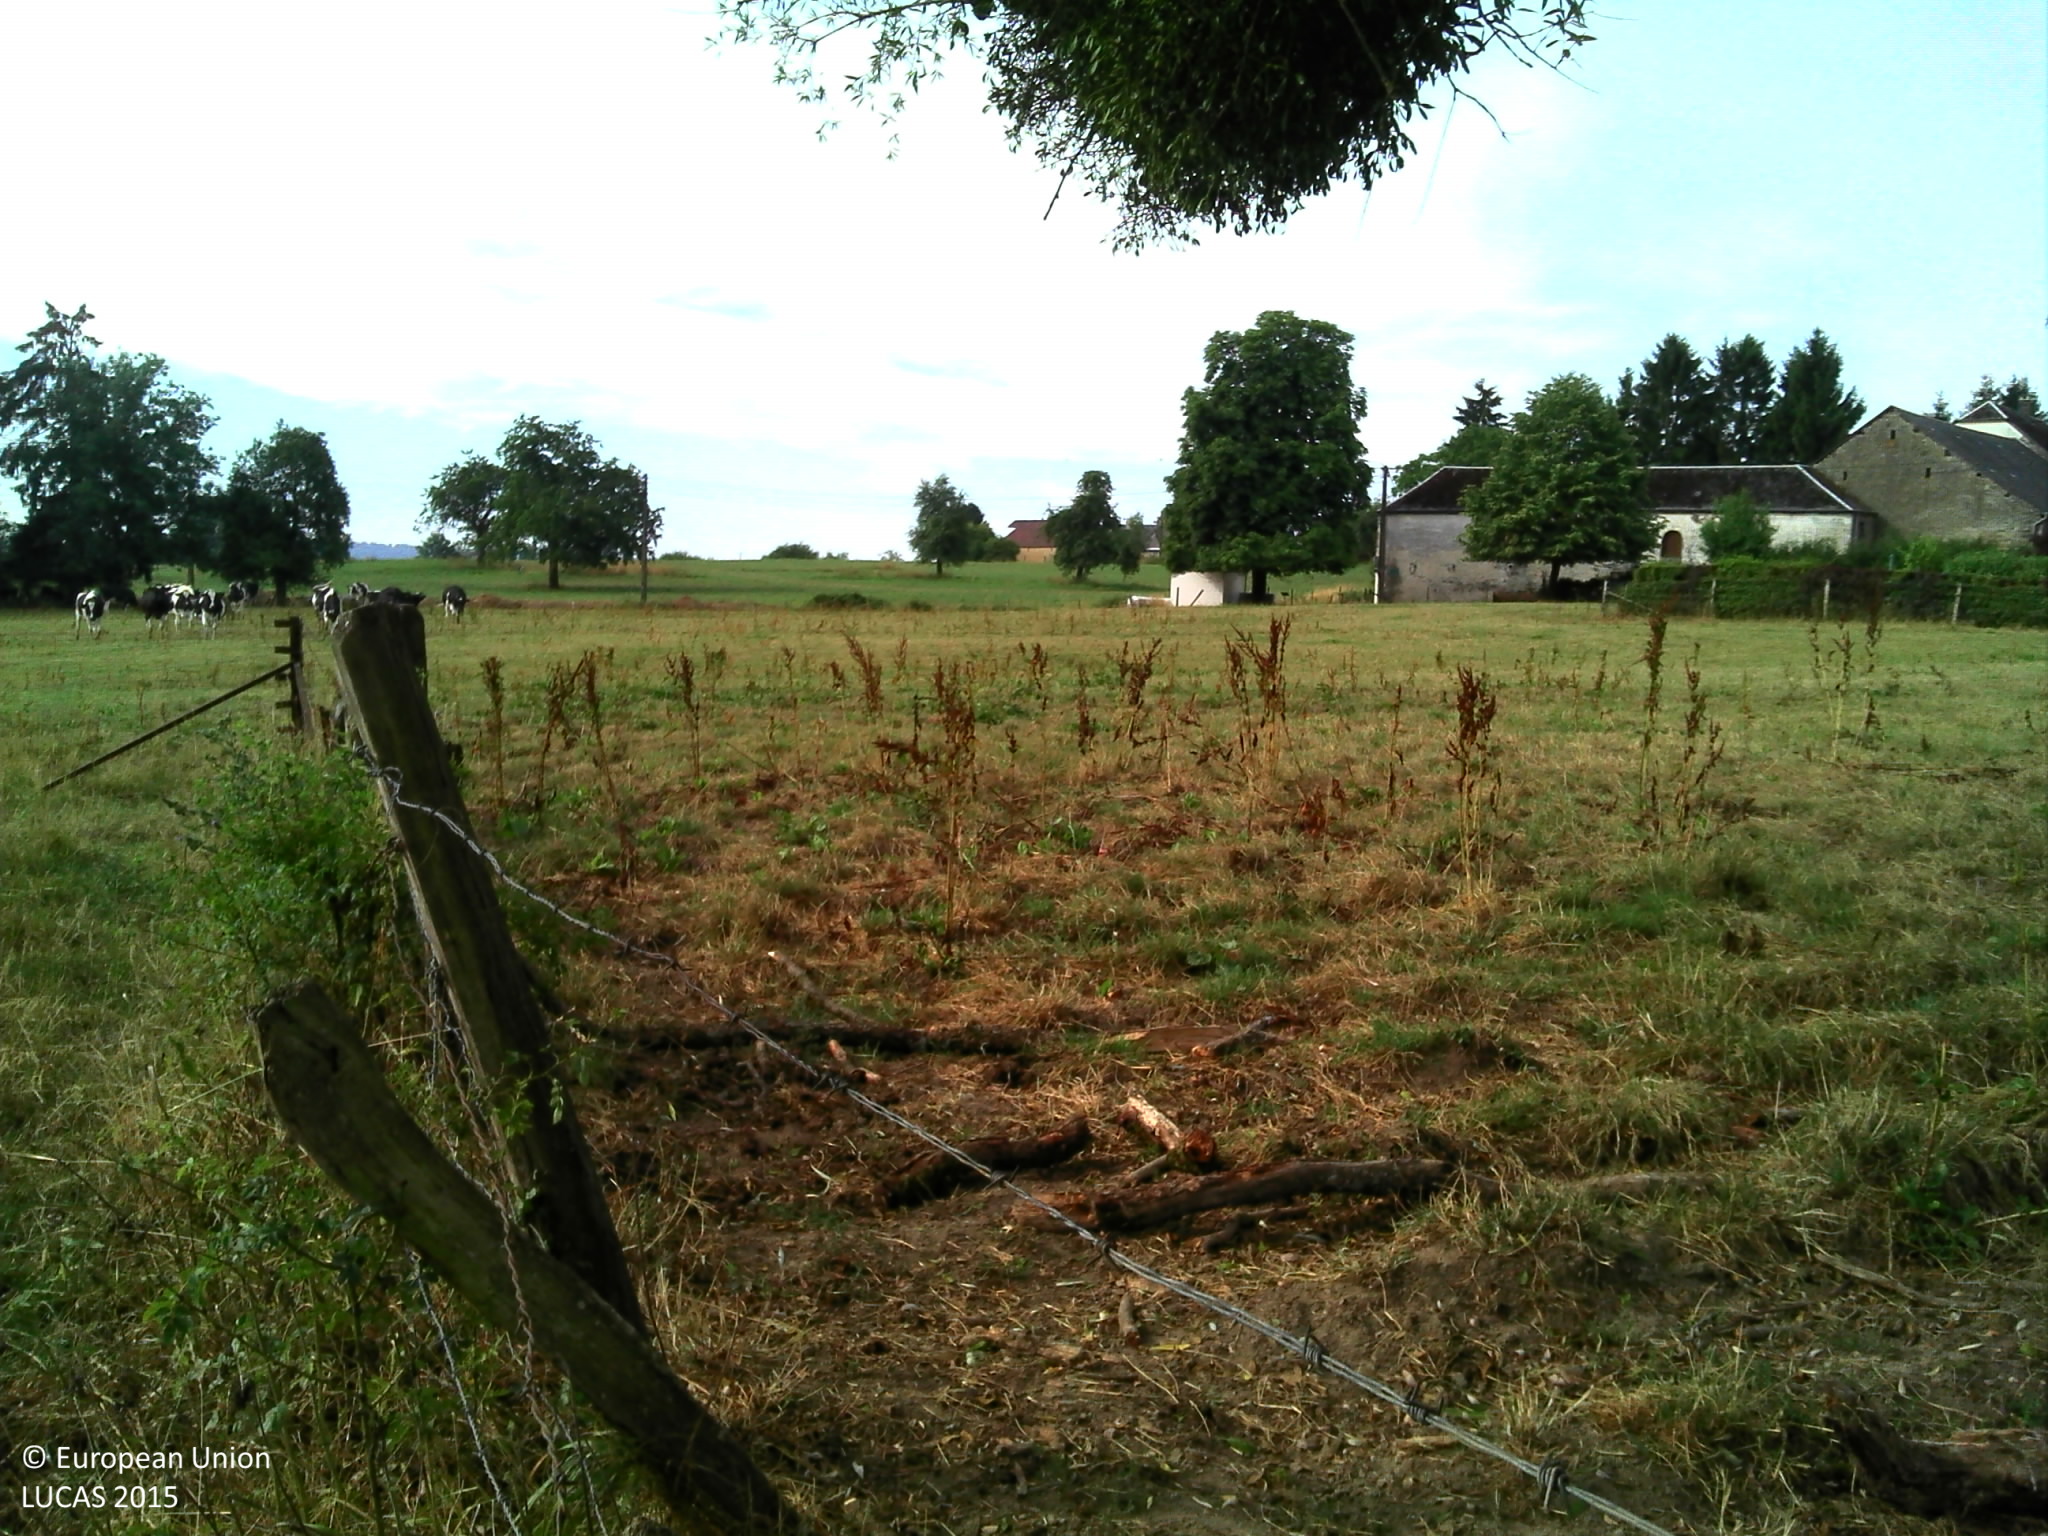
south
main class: Grassland
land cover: Grassland with sparse tree/shrub cover
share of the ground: > 75 %
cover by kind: herbaceous plants 95 %, broadleaved forest trees 5 %
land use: Agriculture (excluding fallow land and kitchen gardens)
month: July
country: BE
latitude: 49.7634
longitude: 5.7646
